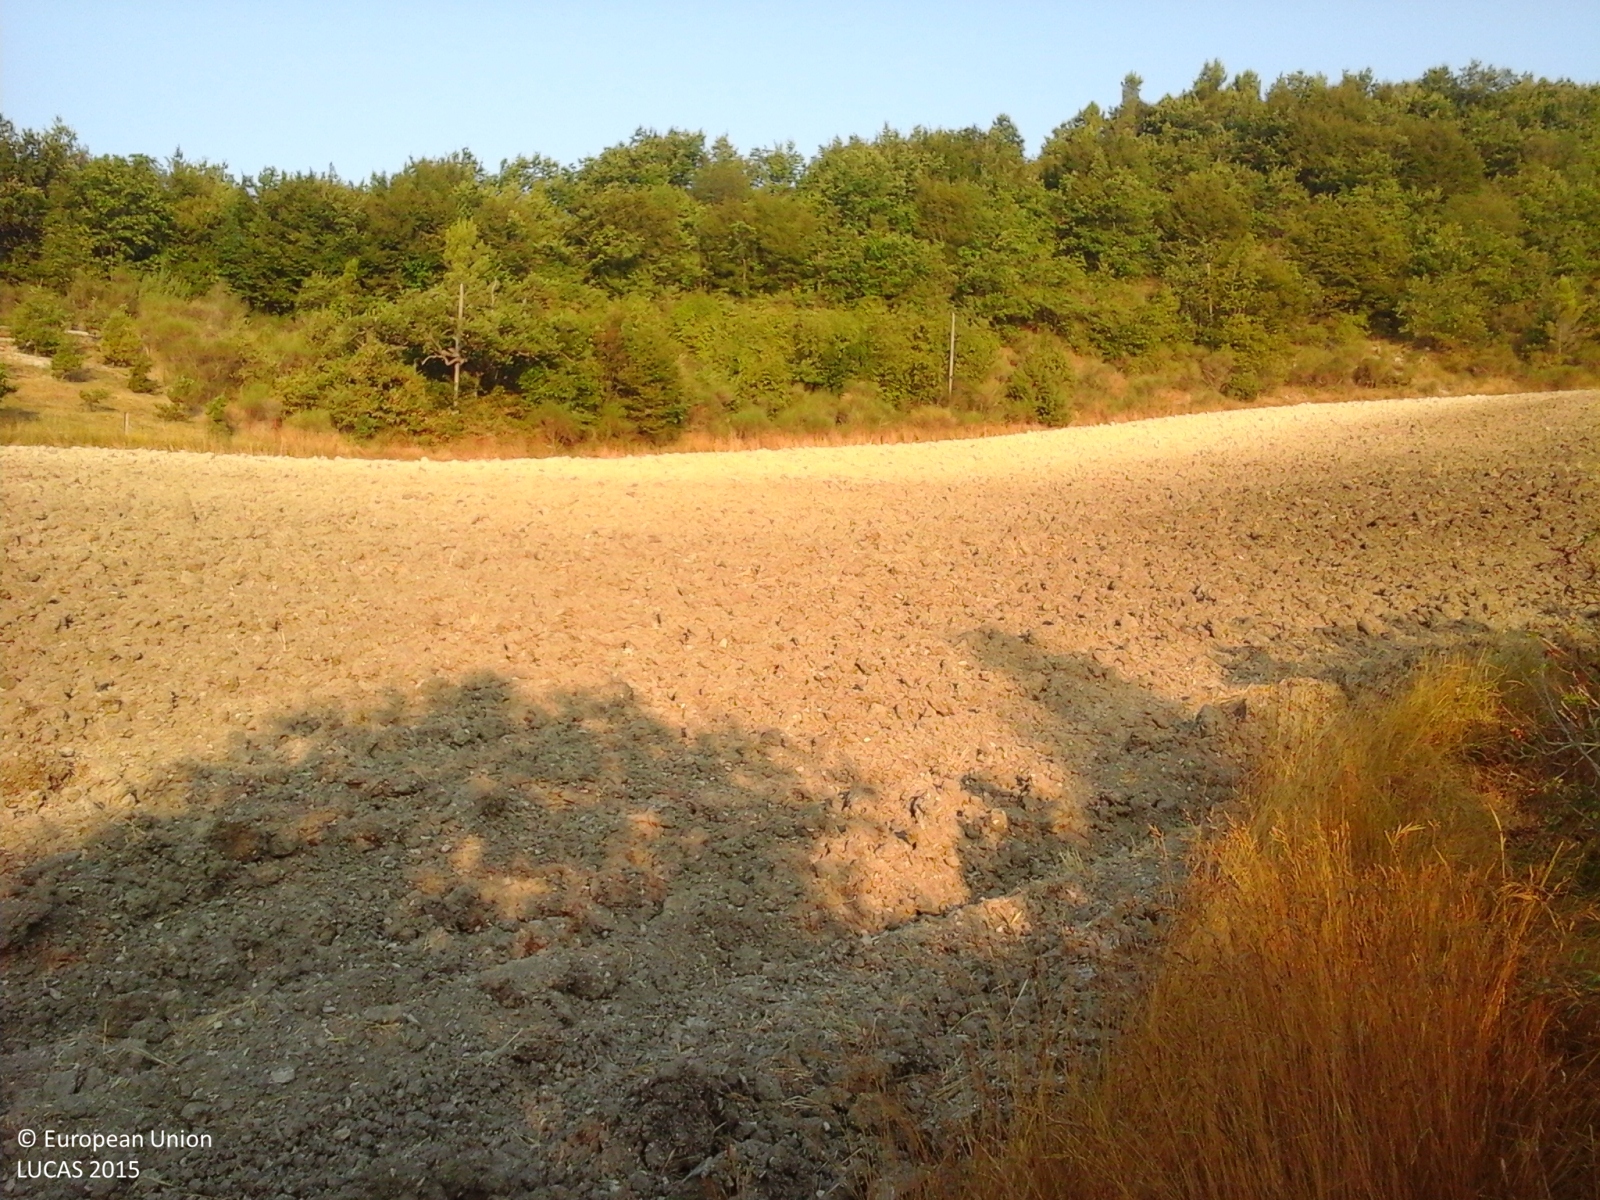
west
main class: Woodland
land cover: Broadleaved woodland
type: thermophilous deciduous forest
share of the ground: > 75 %
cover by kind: broadleaved forest trees 100 %
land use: Forestry
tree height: > 5 m
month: August
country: IT
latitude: 43.6151
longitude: 12.5584
